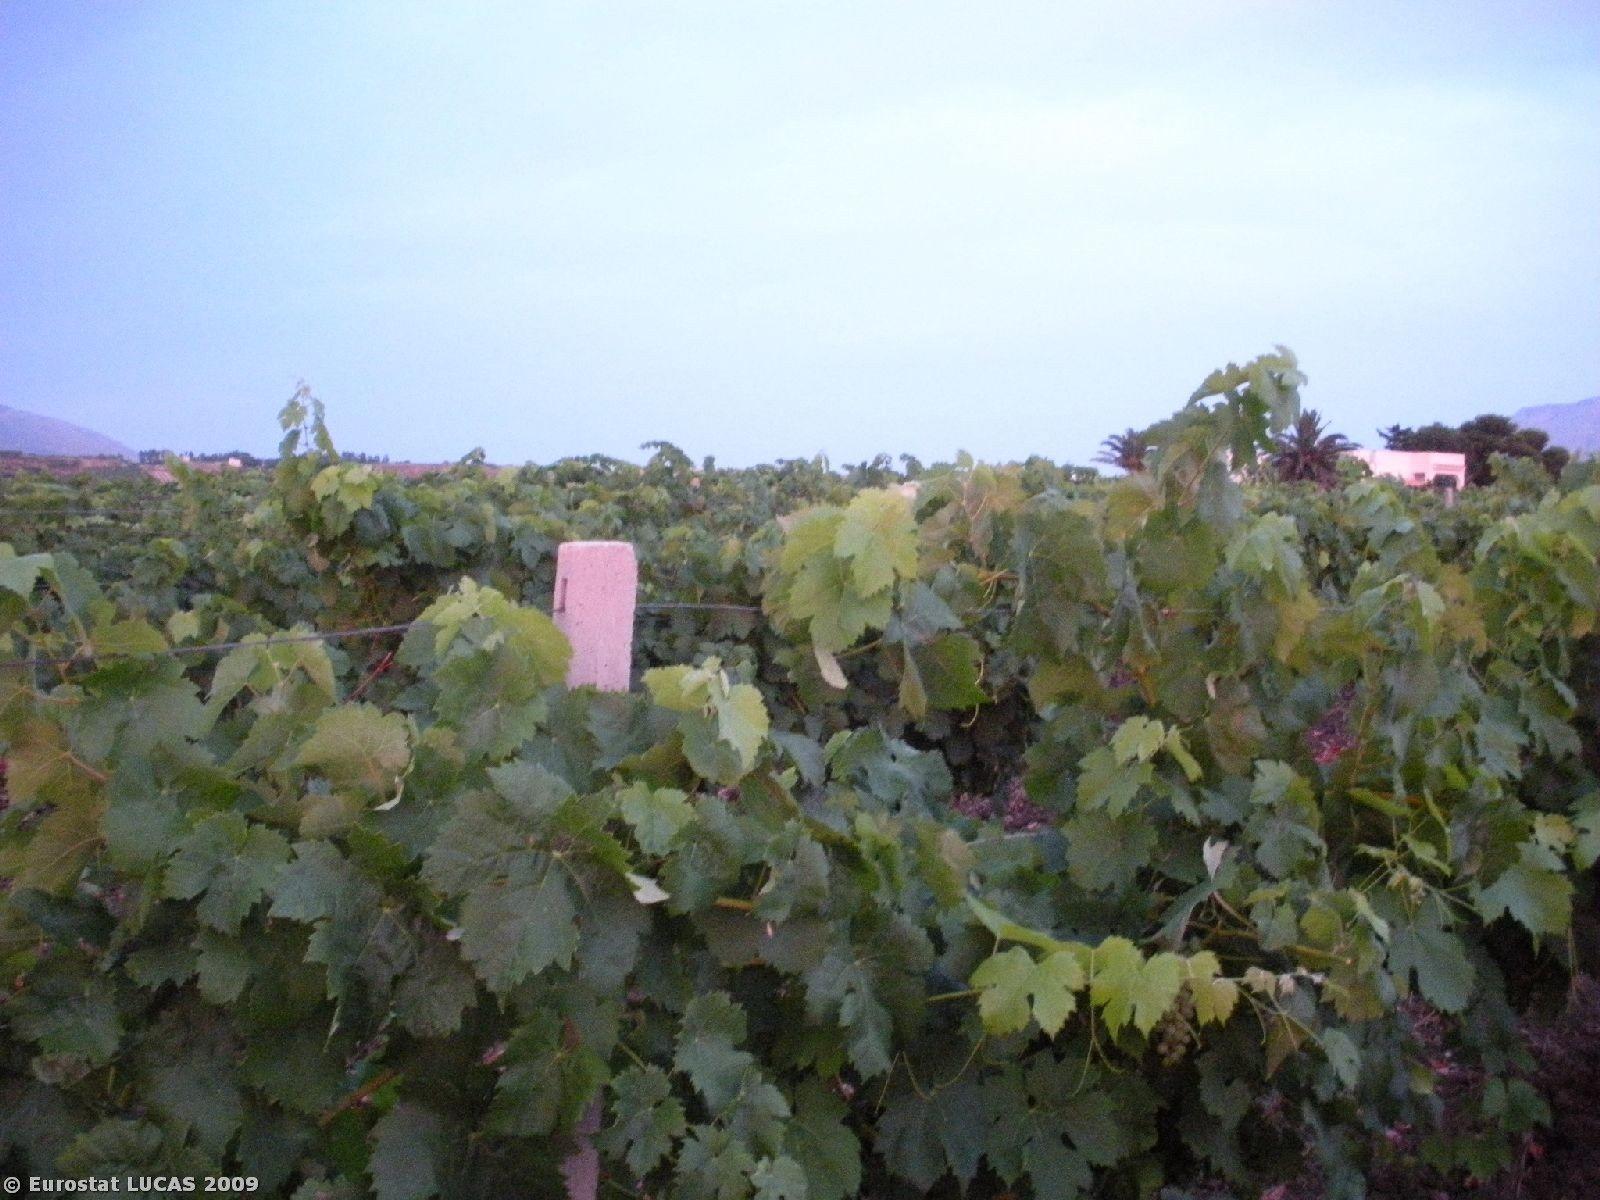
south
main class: Cropland
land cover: Vineyards
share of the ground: 50 - 75 %
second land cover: Bare land
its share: 10 - 25 %
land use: Agriculture (excluding fallow land and kitchen gardens)
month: July
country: IT
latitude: 38.0279
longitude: 12.9749
